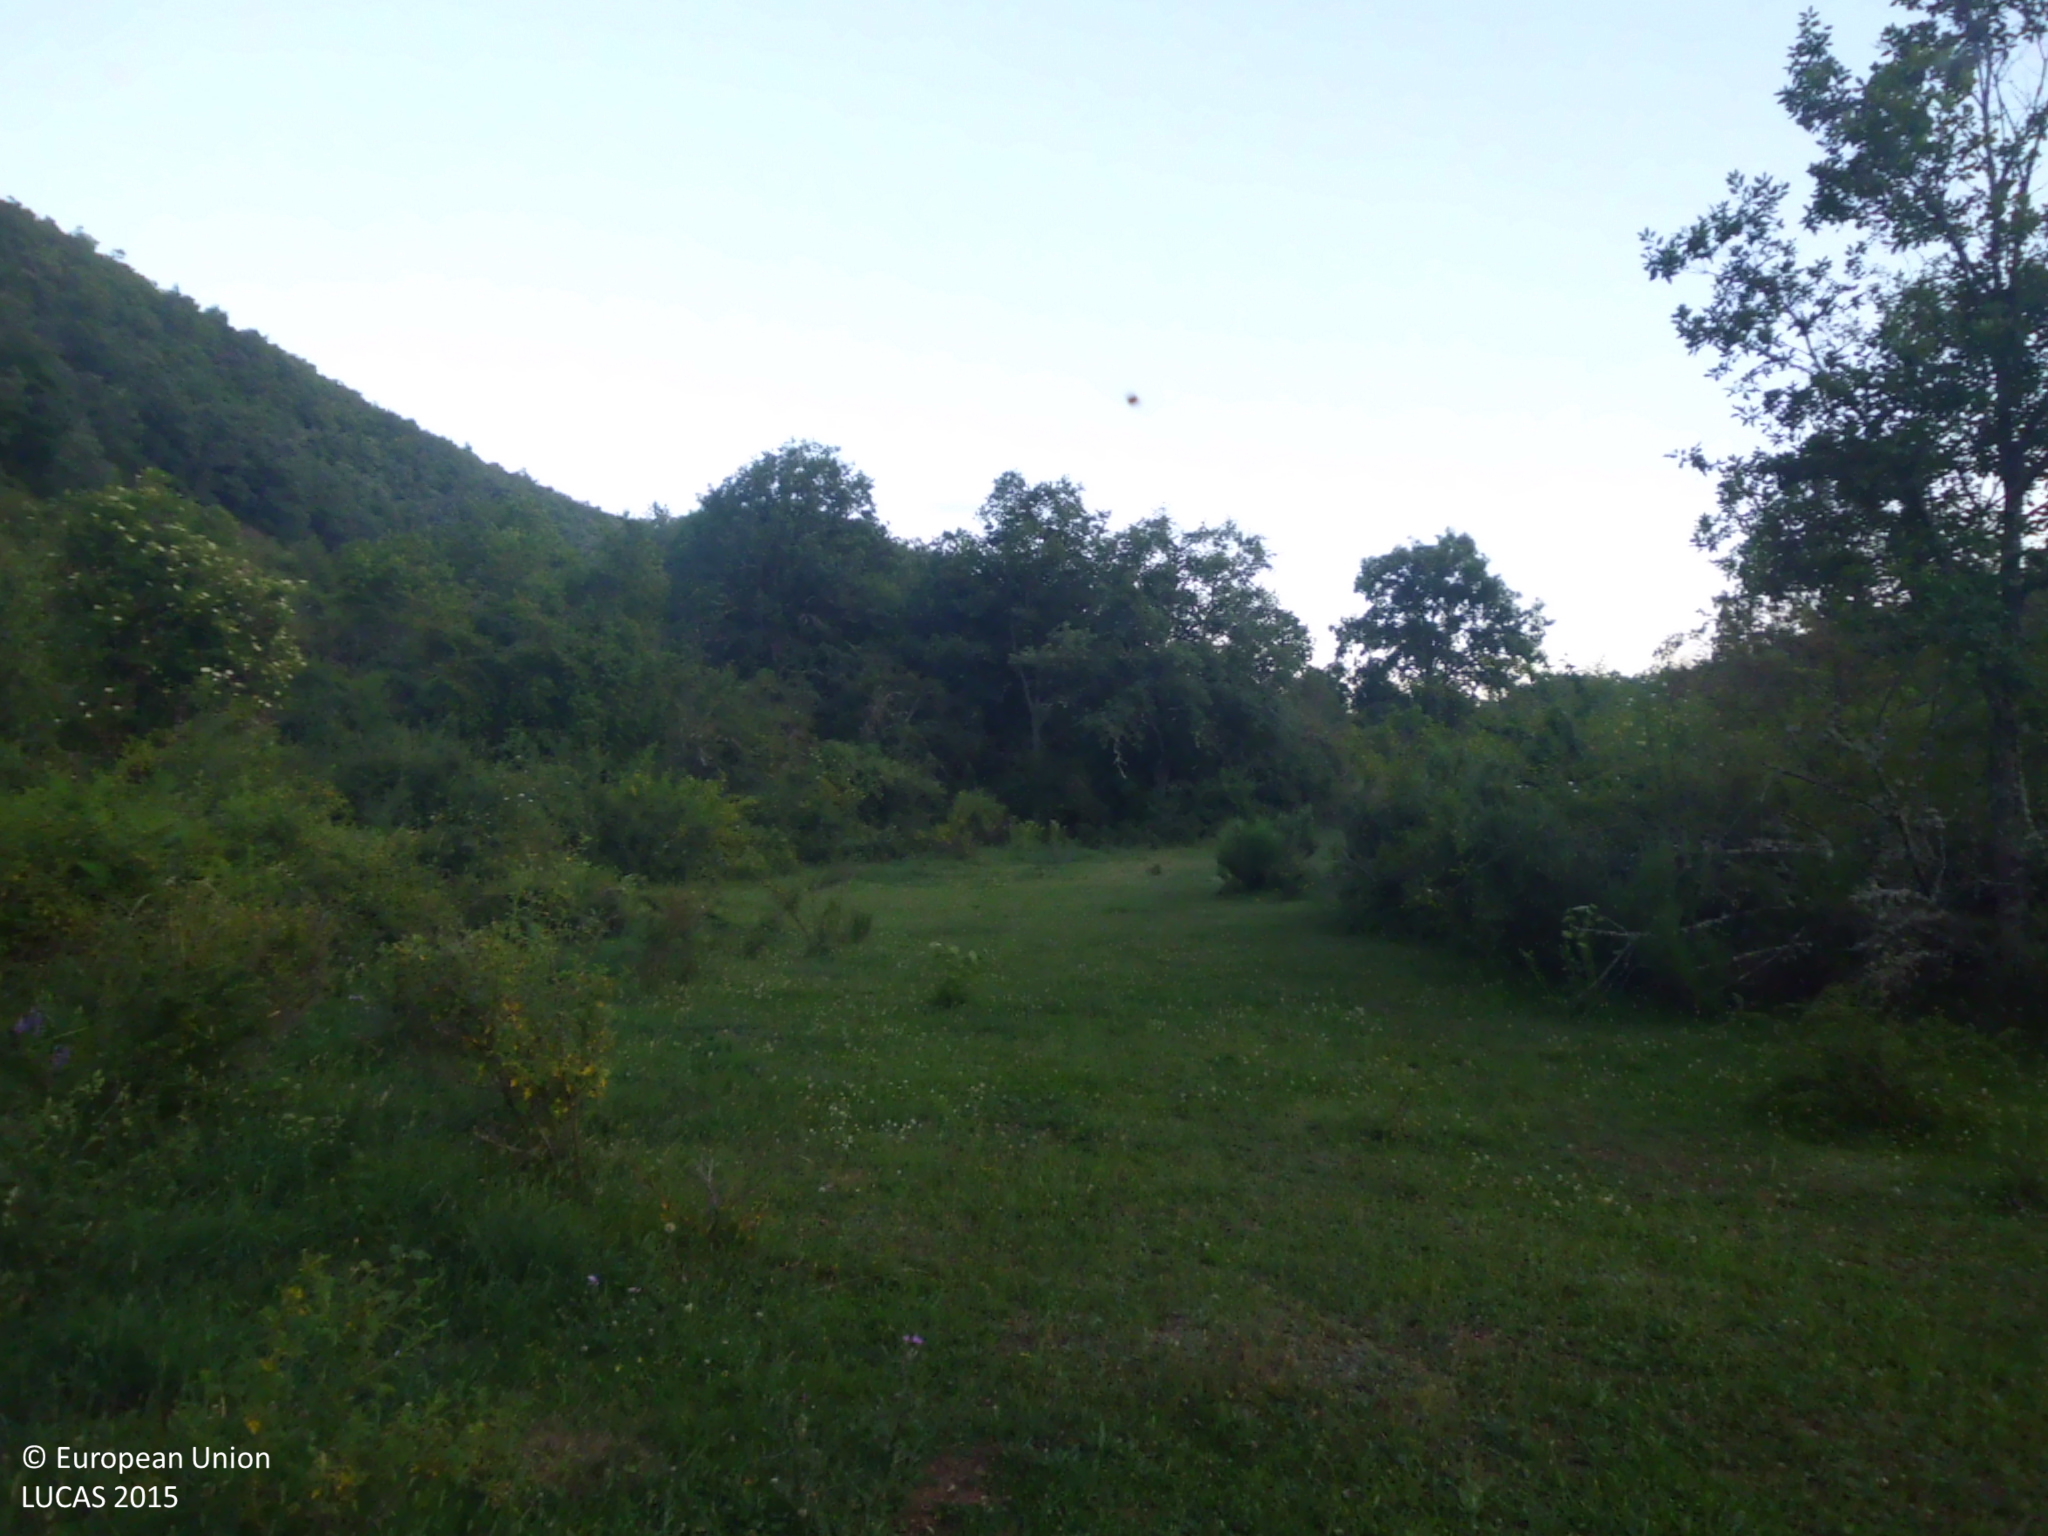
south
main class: Grassland
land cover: Grassland without tree/shrub cover
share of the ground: > 75 %
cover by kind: herbaceous plants 95 %, shrubs 5 %
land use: Abandoned areas
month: June
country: ES
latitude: 42.8384
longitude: -4.9528
